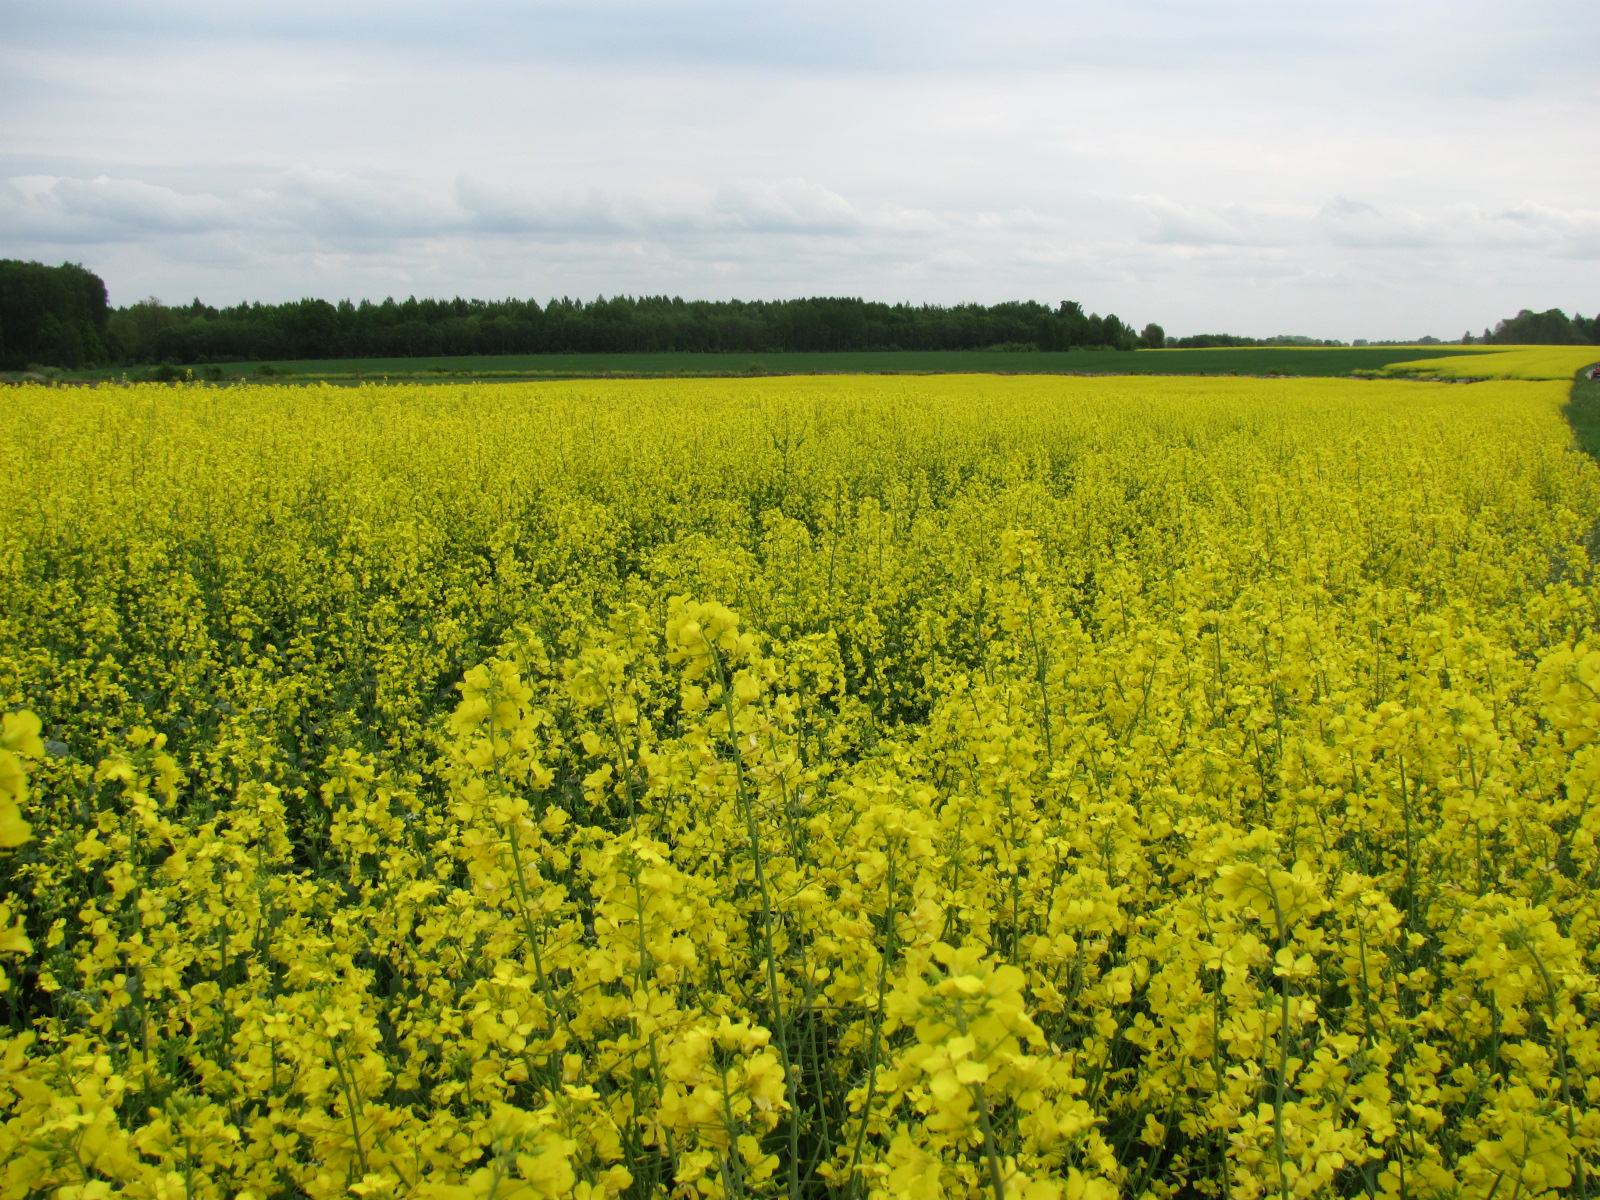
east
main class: Cropland
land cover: Rape and turnip rape
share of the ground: > 75 %
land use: Agriculture (excluding fallow land and kitchen gardens)
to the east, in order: Rape and turnip rape
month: May
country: LV
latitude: 56.4792
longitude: 24.1325
